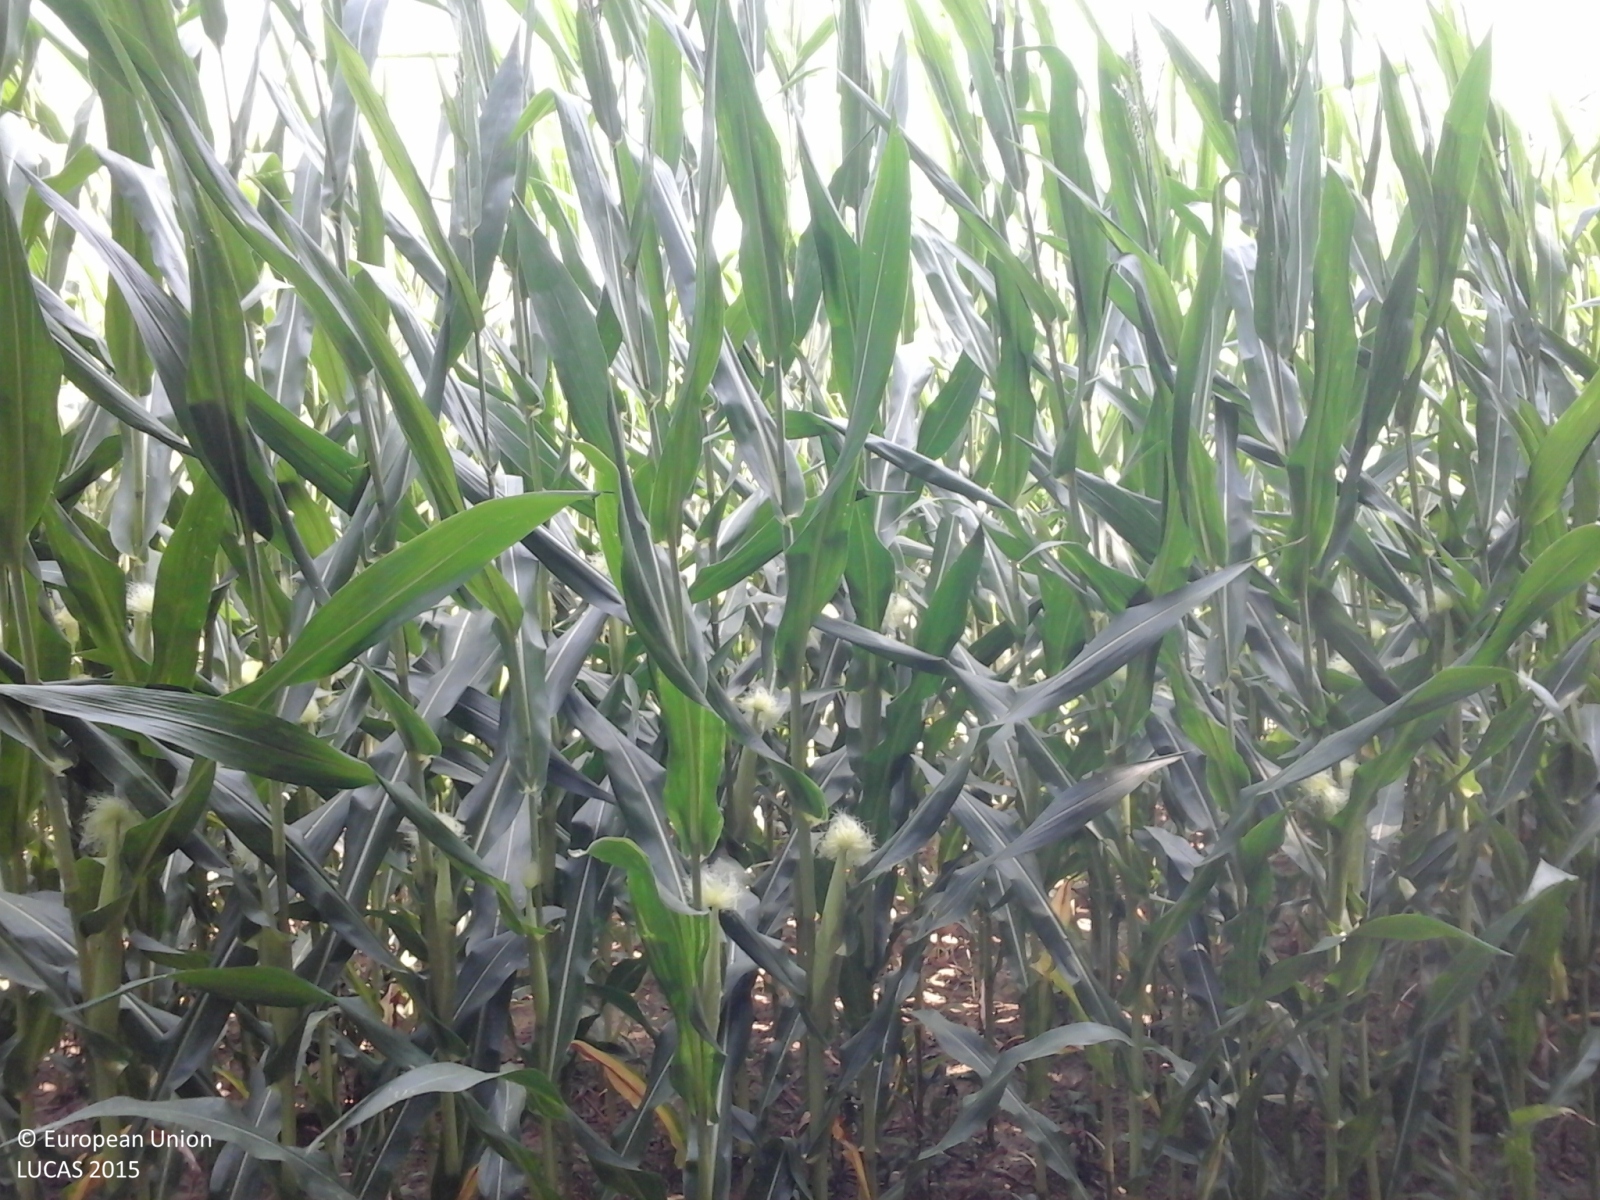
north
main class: Cropland
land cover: Maize
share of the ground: > 75 %
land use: Agriculture (excluding fallow land and kitchen gardens)
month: July
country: IT
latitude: 45.1401
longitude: 9.0988
